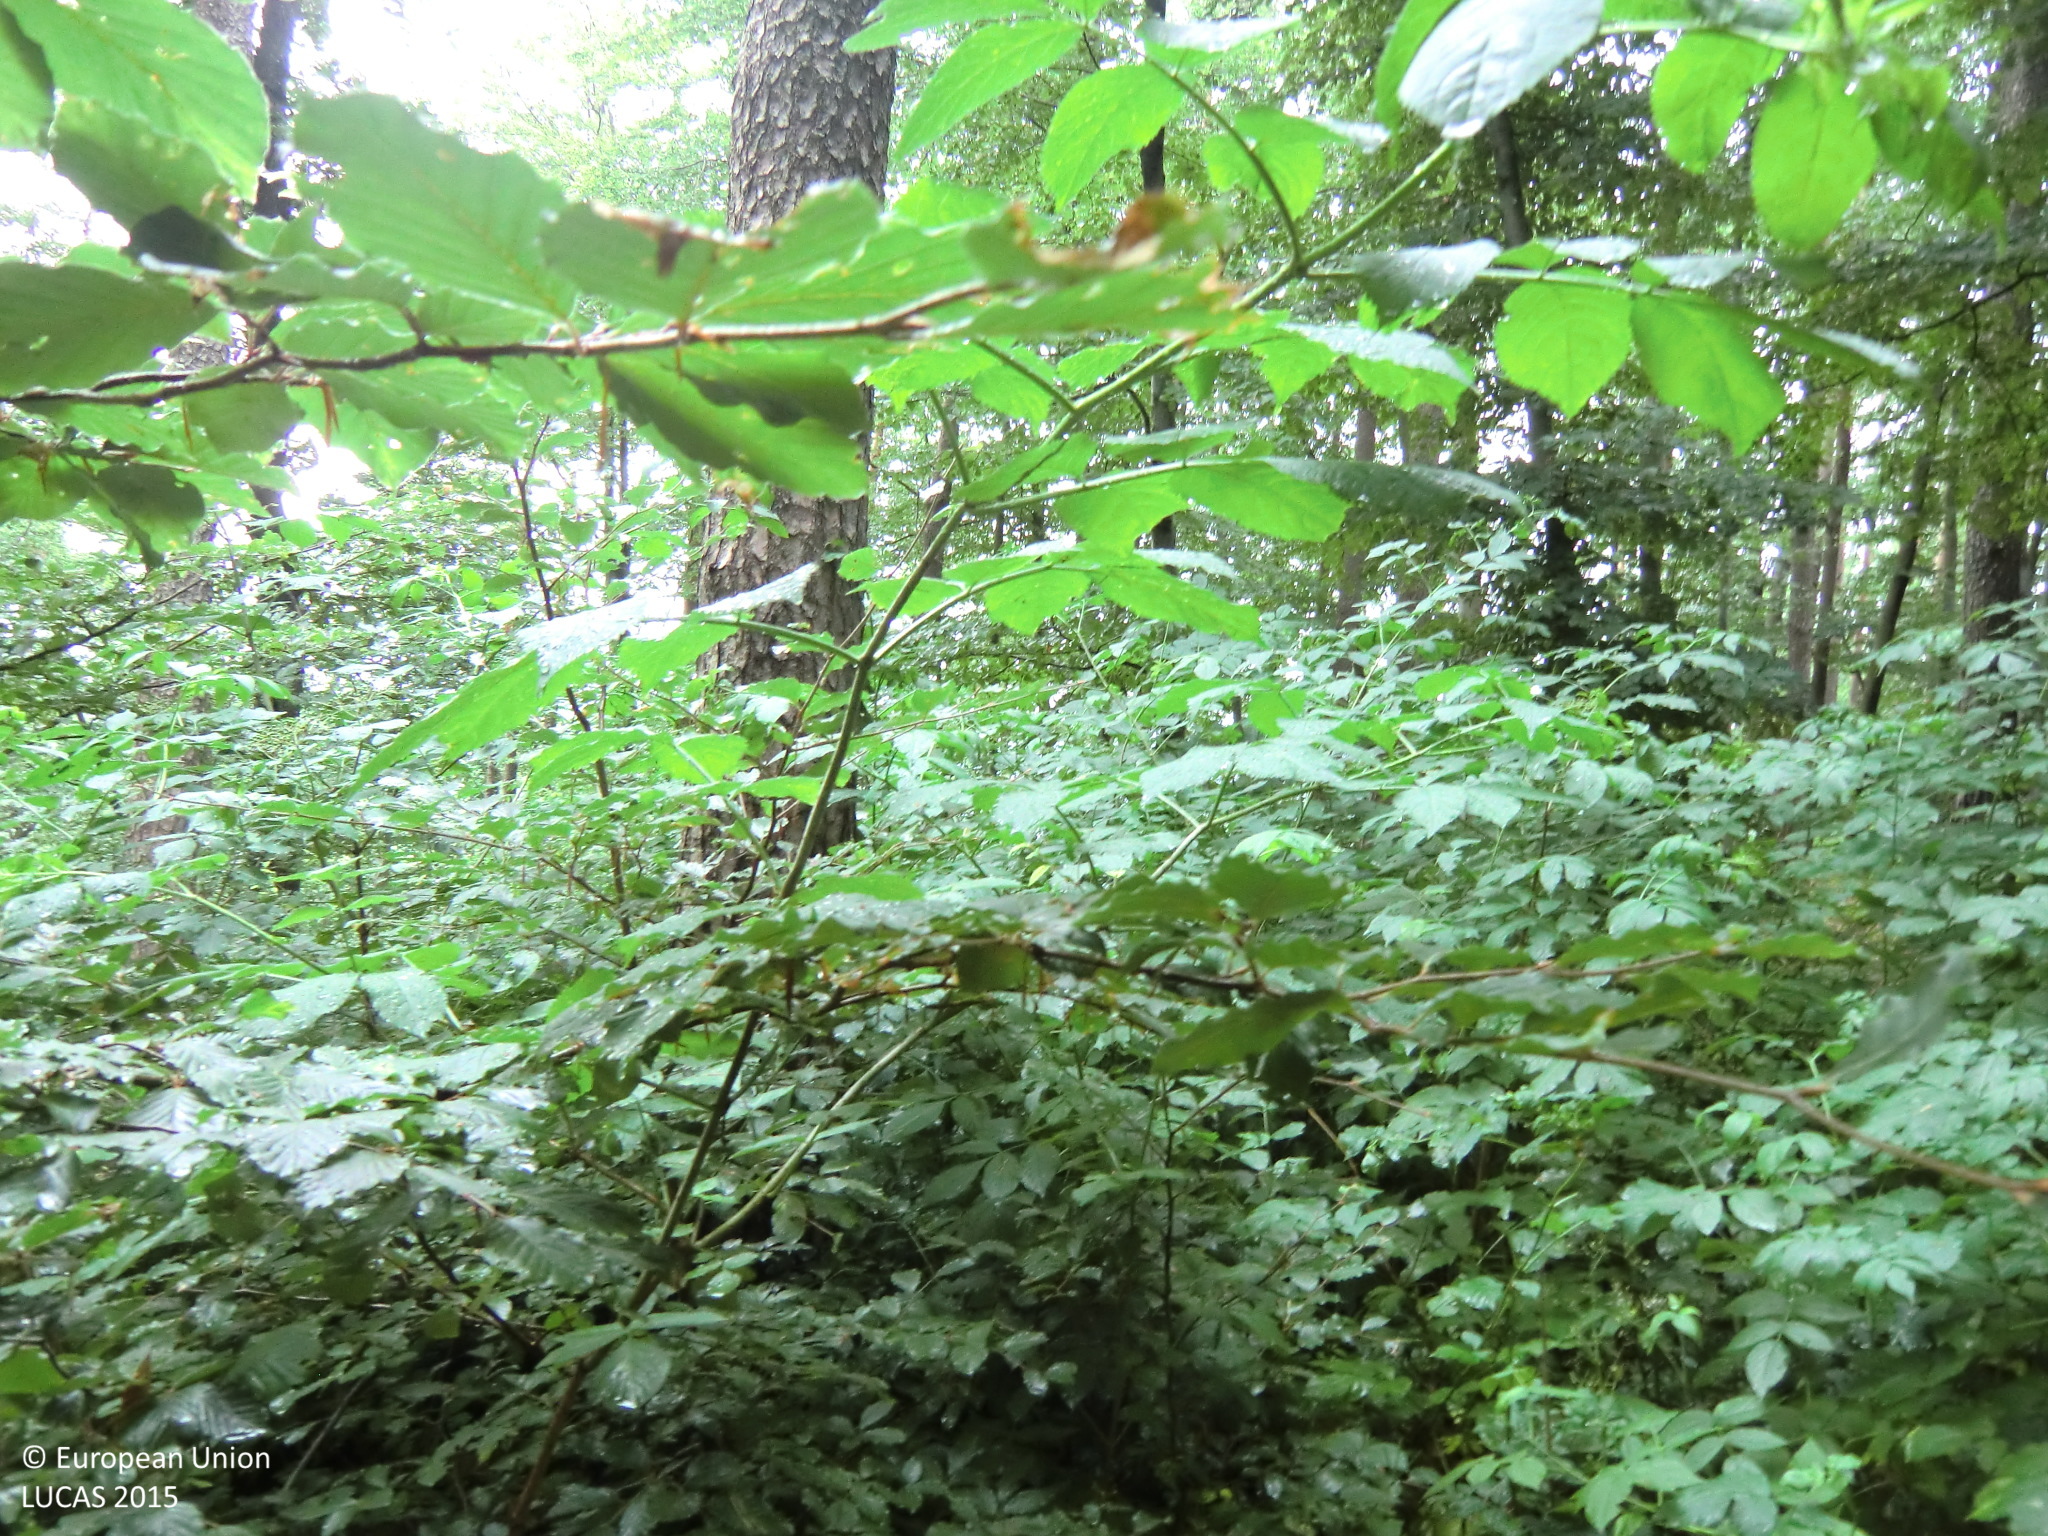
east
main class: Woodland
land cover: Pine dominated mixed woodland
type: hemiboreal forest and nemoral coniferous forest and mixed broadleaved-coniferous forest
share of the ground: 50 - 75 %
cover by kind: broadleaved forest trees 40 %, coniferous forest trees 30 %, shrubs 20 %, unconsolidated bare surface 10 %
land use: Forestry
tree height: > 5 m
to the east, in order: Pine dominated mixed woodland; Tracks; Broadleaved woodland; Tracks; Shrubland with sparse tree cover; Pine dominated mixed woodland; Tracks; Pine dominated mixed woodland
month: July
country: AT
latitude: 47.1137
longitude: 15.4693
